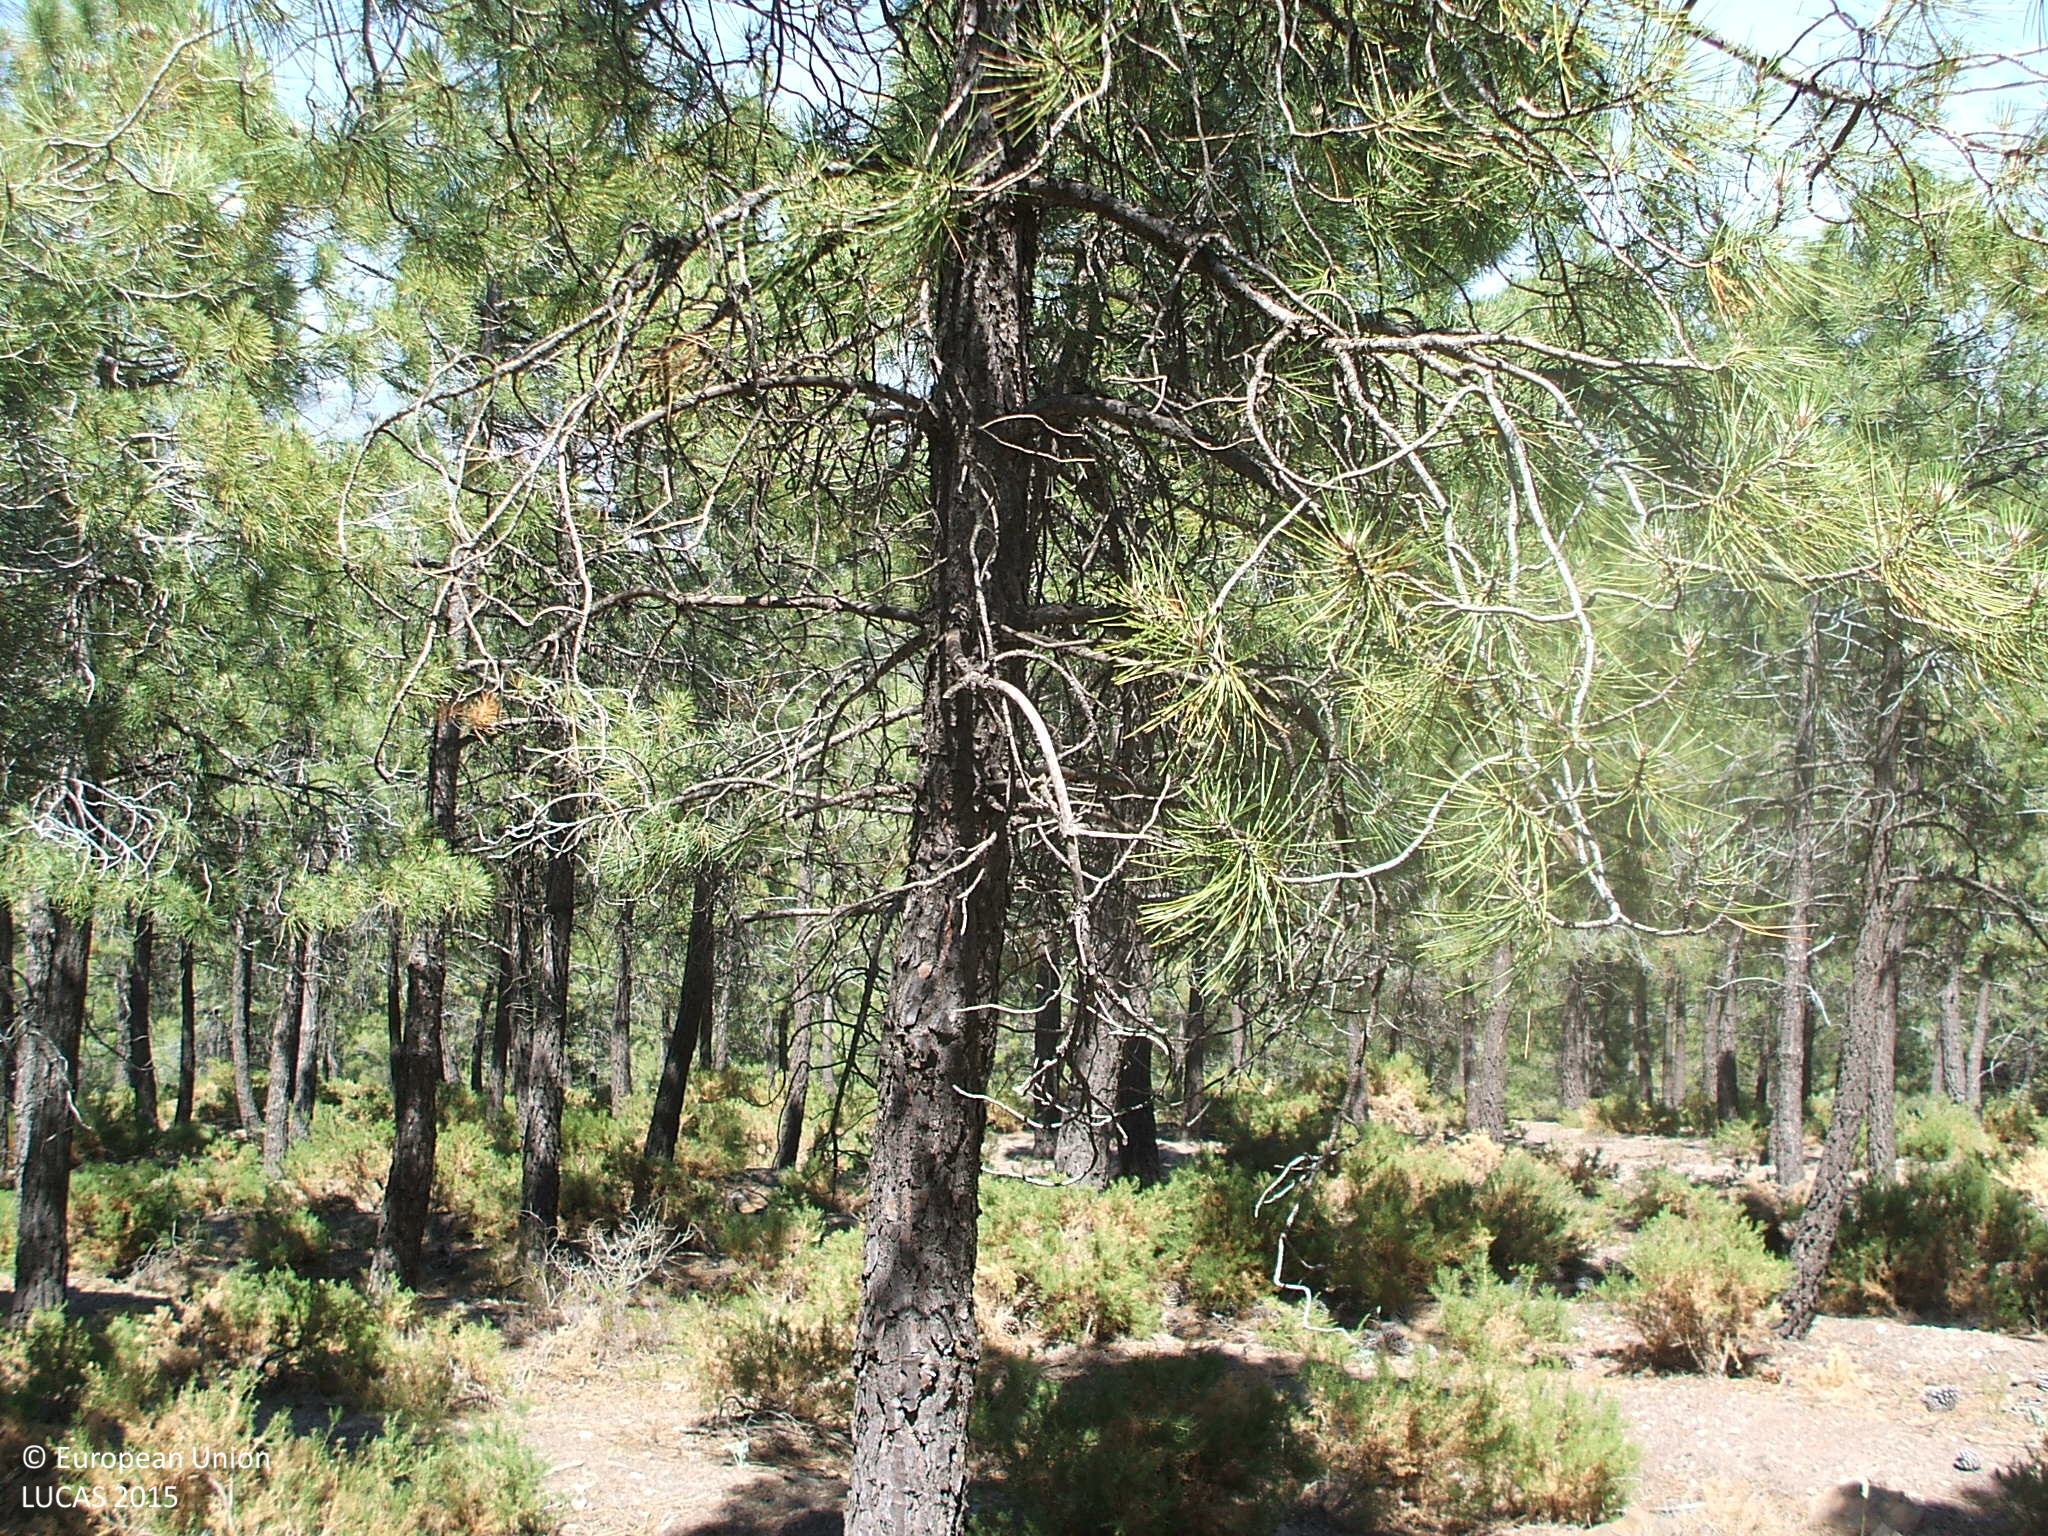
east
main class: Woodland
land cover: Pine dominated coniferous woodland
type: coniferous forest of the mediterranean region
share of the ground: > 75 %
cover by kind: coniferous forest trees 80 %, shrubs 20 %
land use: Semi-natural and natural areas not in use
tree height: > 5 m
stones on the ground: > 50 %
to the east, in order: Pine dominated coniferous woodland; Tracks; Pine dominated coniferous woodland; Rivers and streams; Pine dominated coniferous woodland
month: June
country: ES
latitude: 37.1022
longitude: -2.7748
